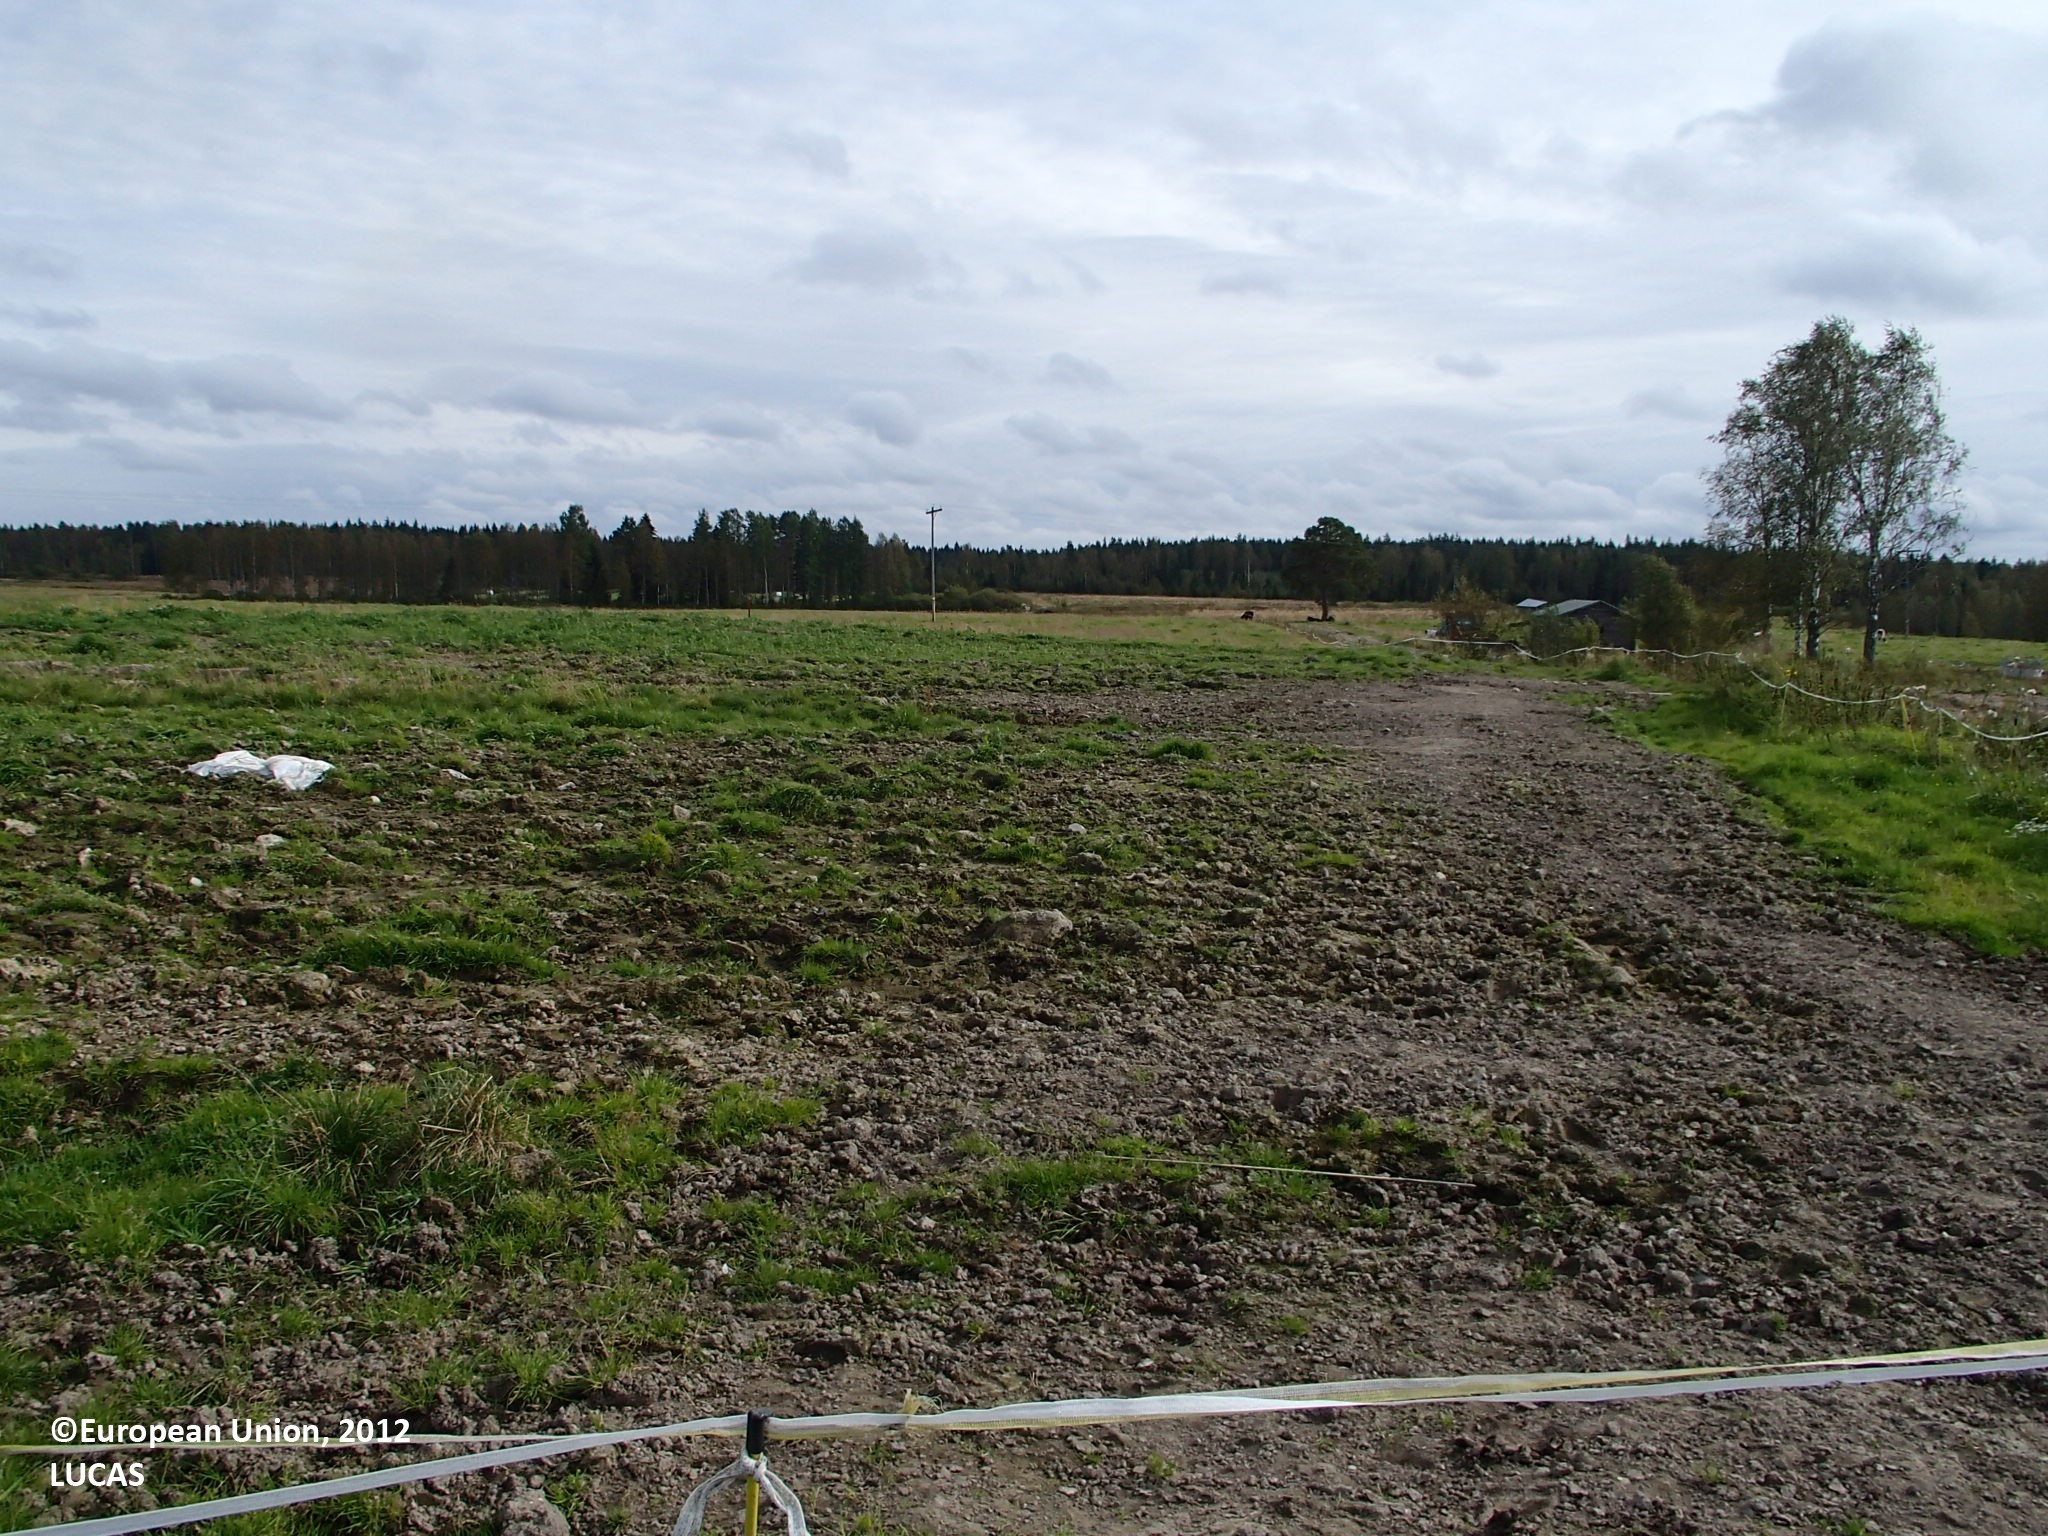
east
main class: Cropland
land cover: Temporary grasslands
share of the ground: > 75 %
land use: Agriculture (excluding fallow land and kitchen gardens)
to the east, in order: Temporary grasslands; Ditches and canals; Temporary grasslands; Electric lines; Temporary grasslands; Ditches and canals; Temporary grasslands; Ditches and canals; Temporary grasslands; Ditches and canals; Temporary grasslands; Ditches and canals; Broadleaved woodland; Ditches and canals; Temporary grasslands; Ditches and canals; Temporary grasslands; Ditches and canals; Temporary grasslands; Ditches and canals; Temporary grasslands; Ditches and canals; Temporary grasslands
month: September
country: FI
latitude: 63.7864
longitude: 25.9566
